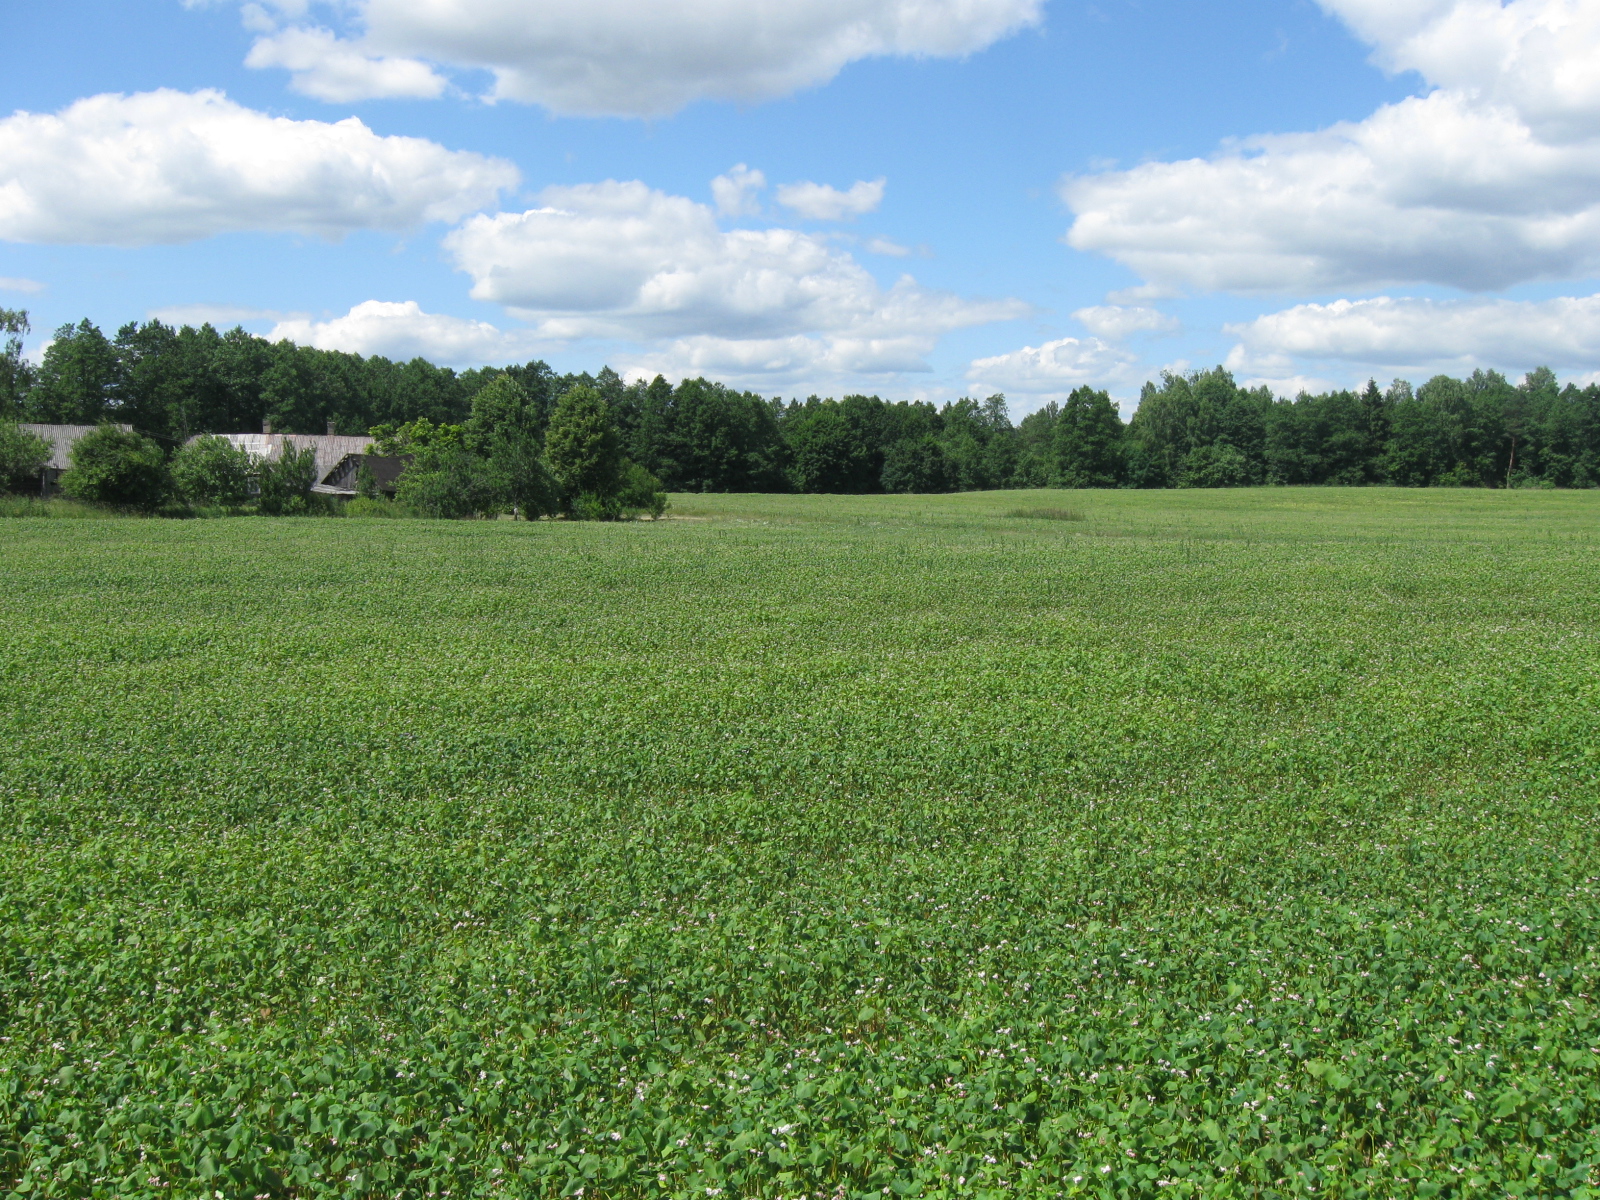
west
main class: Cropland
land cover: Other cereals
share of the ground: > 75 %
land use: Agriculture (excluding fallow land and kitchen gardens)
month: July
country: LT
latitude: 54.3385
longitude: 24.6099
